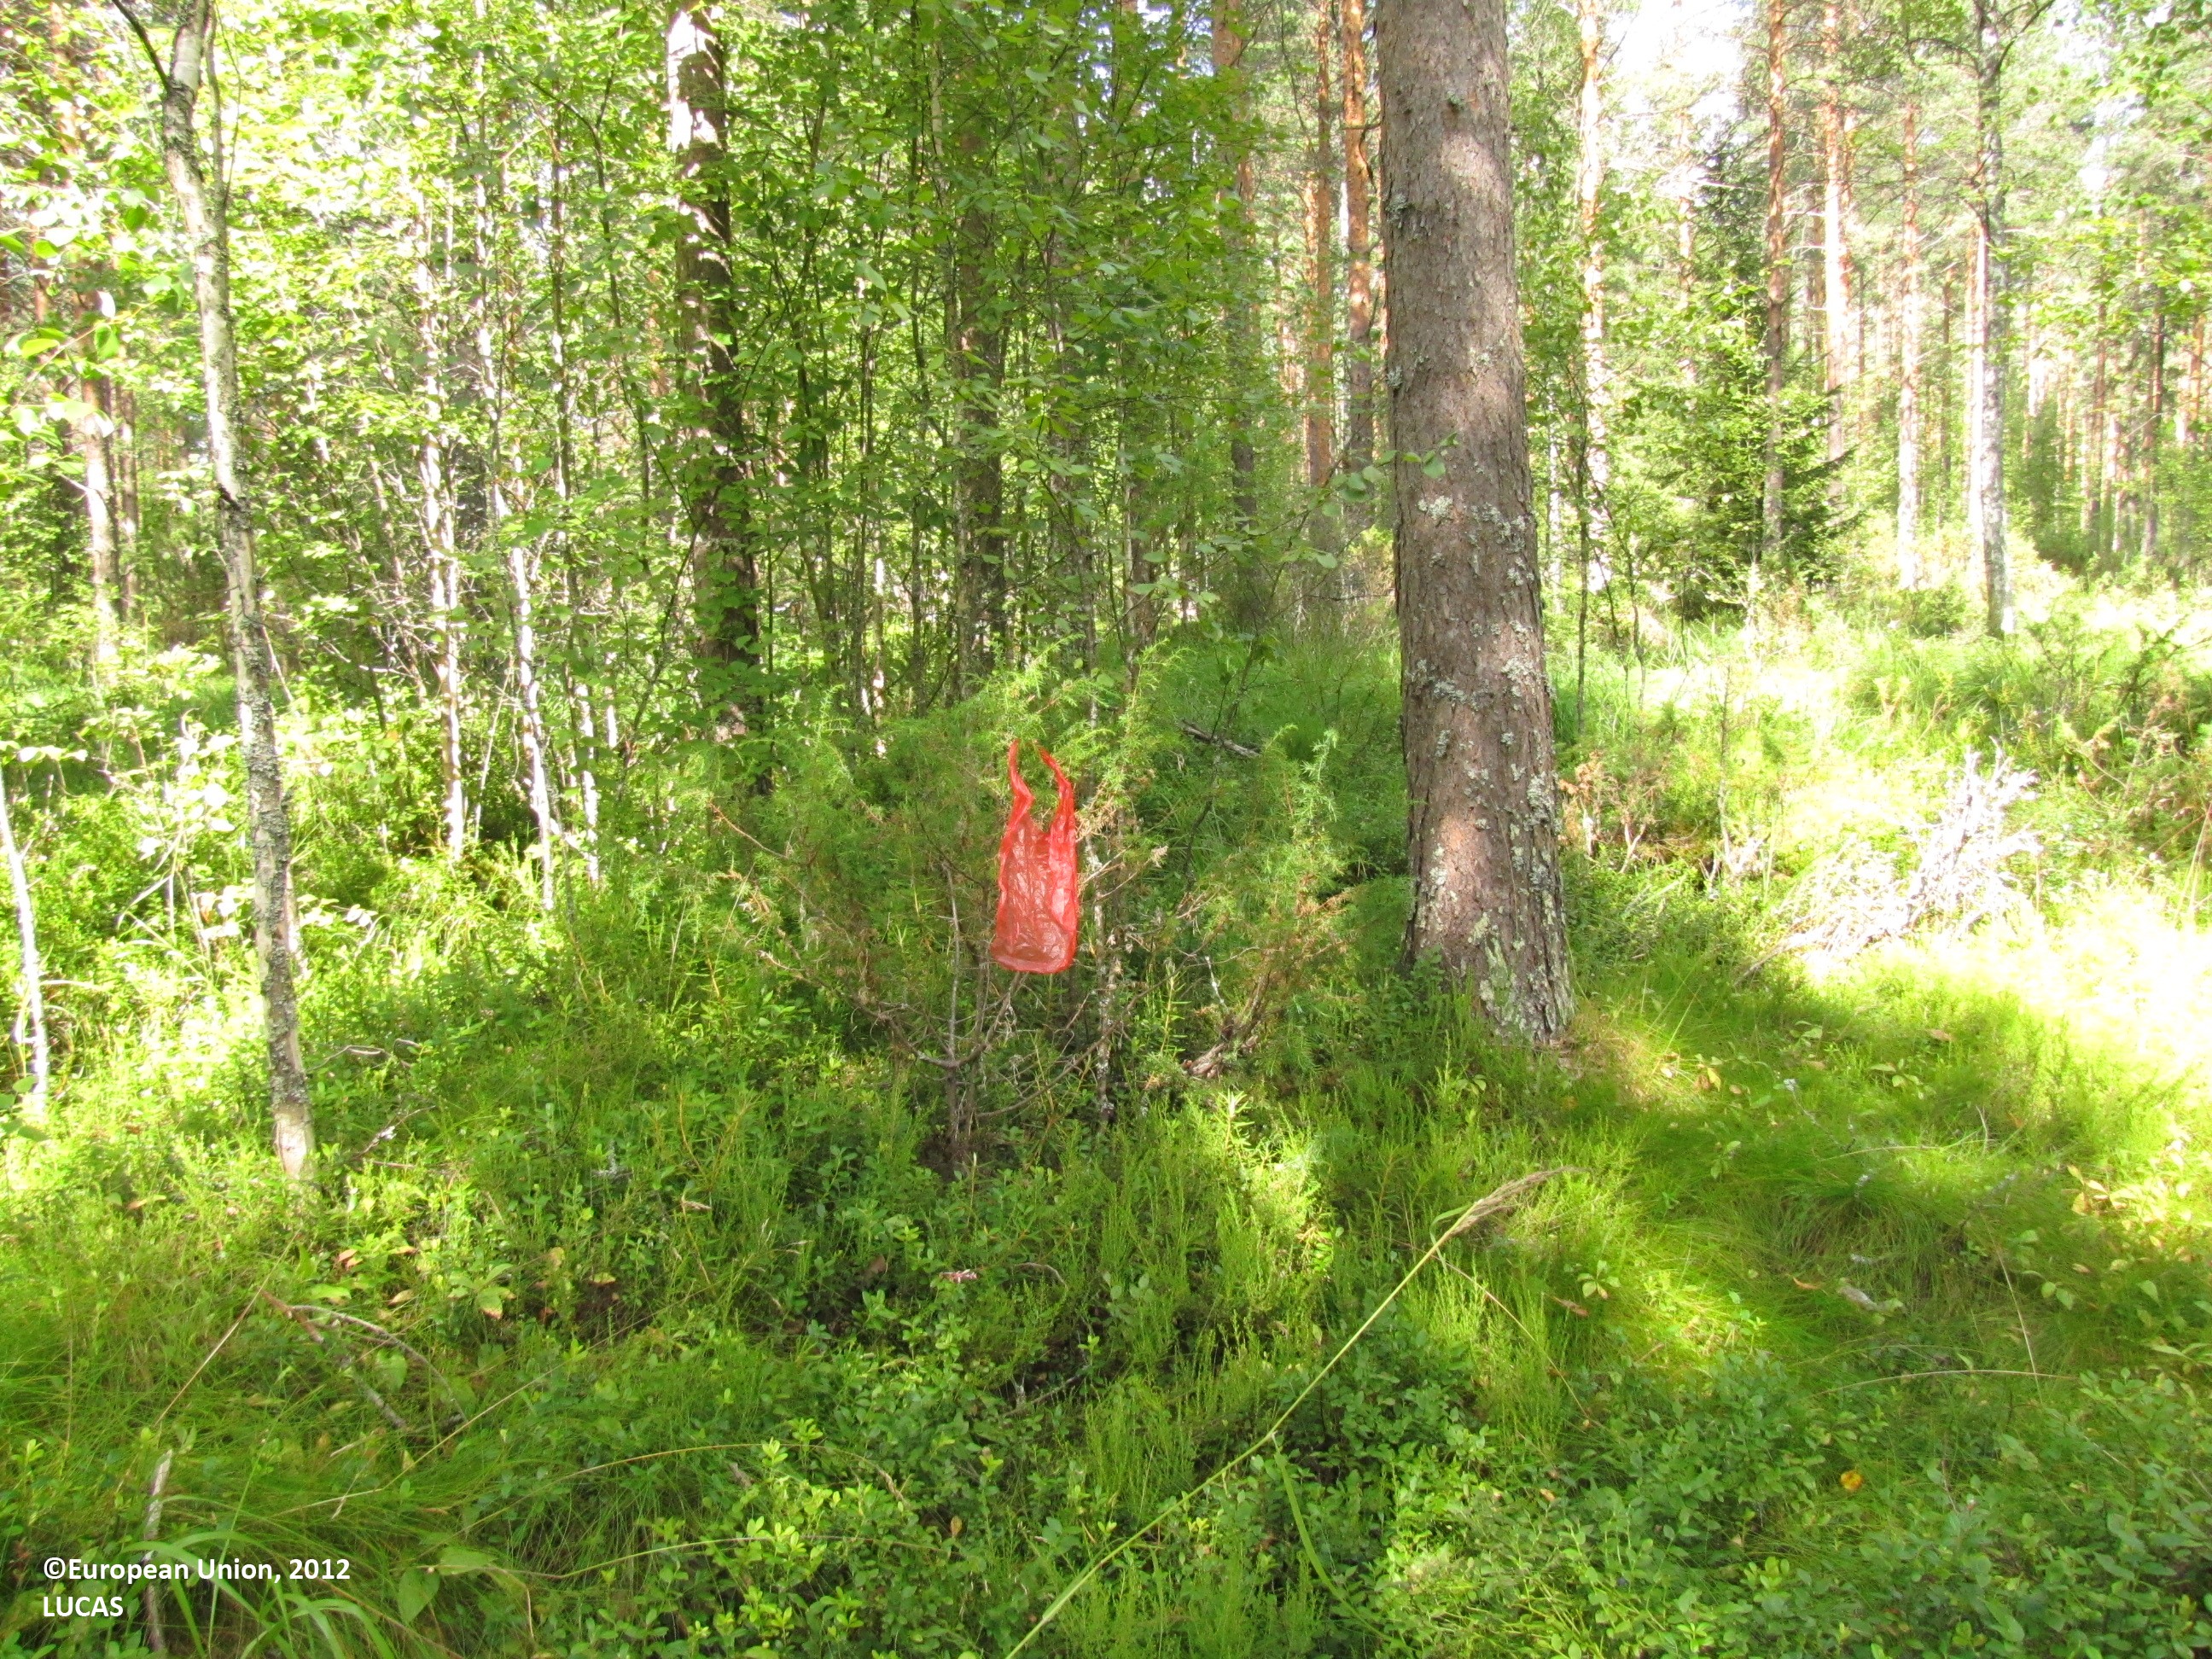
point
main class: Woodland
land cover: Pine dominated mixed woodland
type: boreal forest
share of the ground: > 75 %
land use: Forestry
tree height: > 5 m
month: August
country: FI
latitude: 61.7268
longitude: 22.8794
